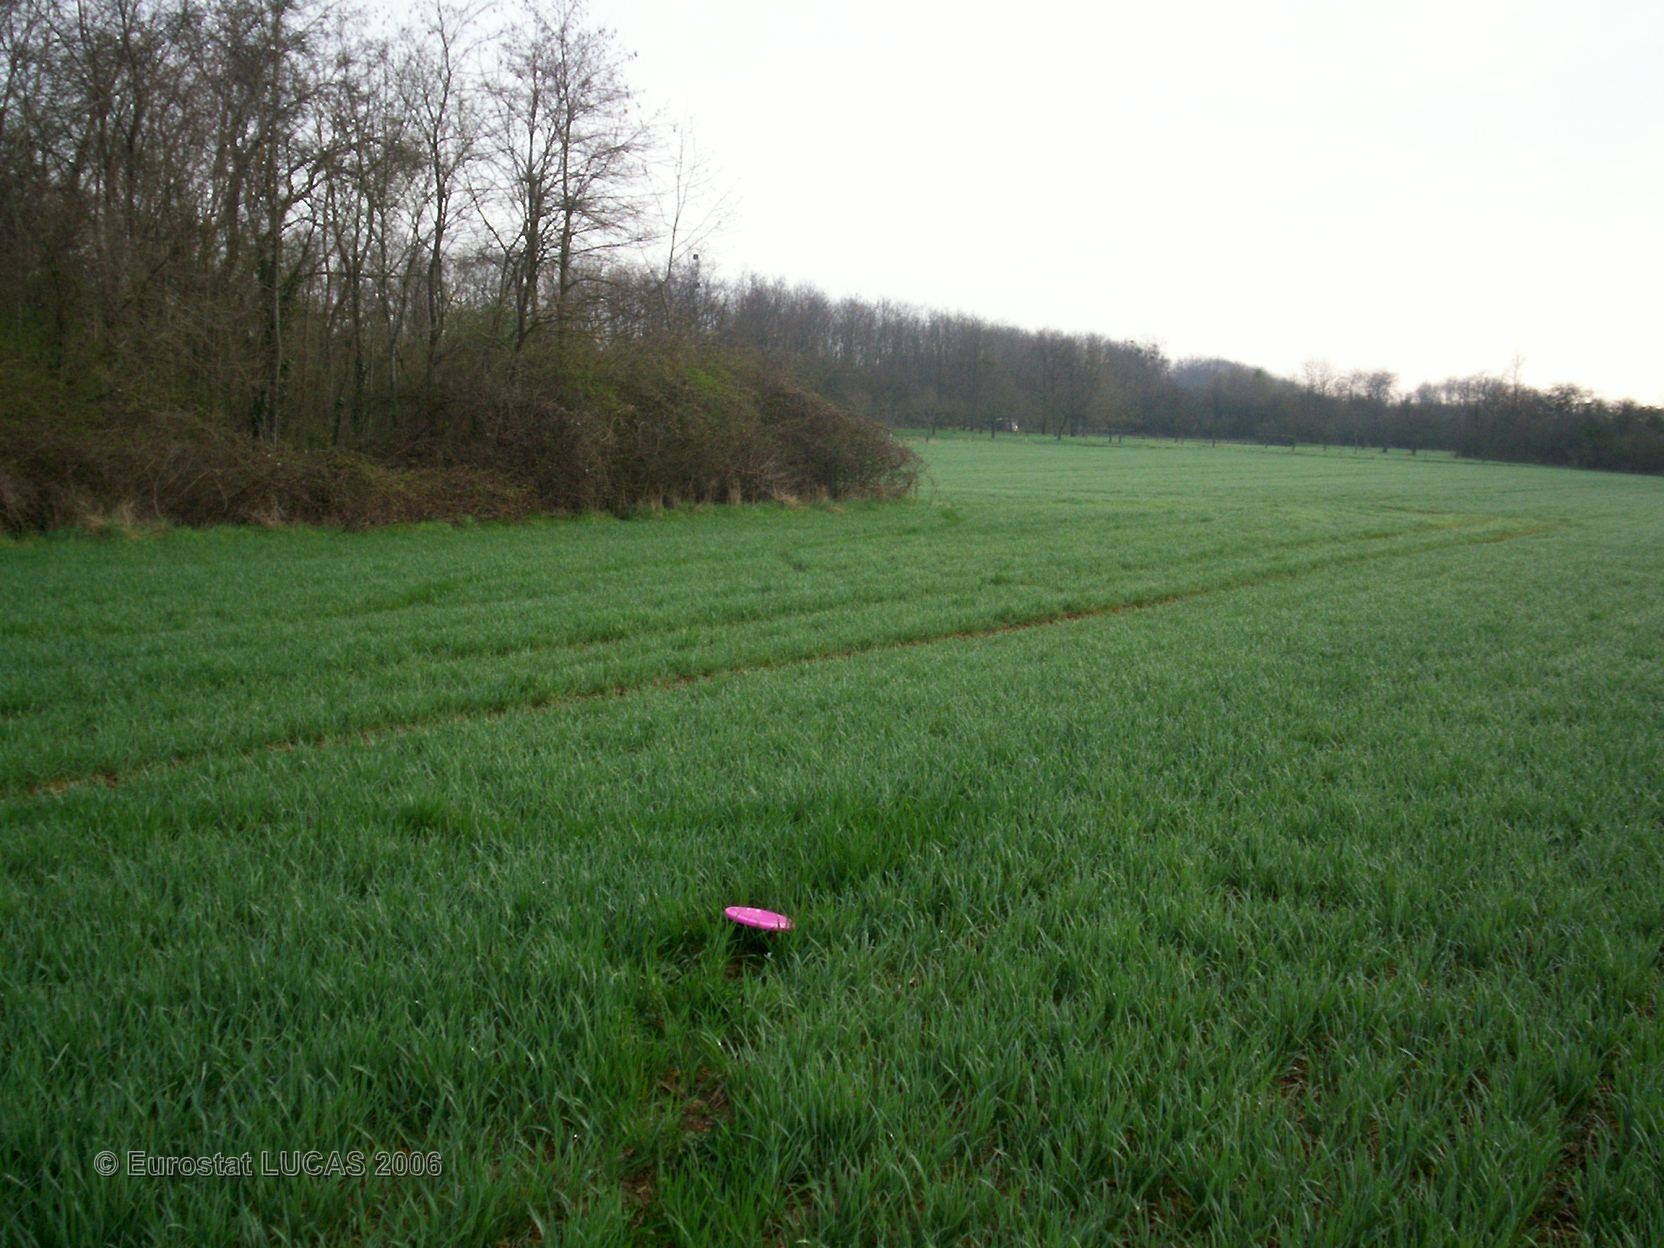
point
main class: Cropland
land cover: Common wheat
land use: Agriculture (excluding fallow land and kitchen gardens)
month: April
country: FR
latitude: 48.6543
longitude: 5.9680
